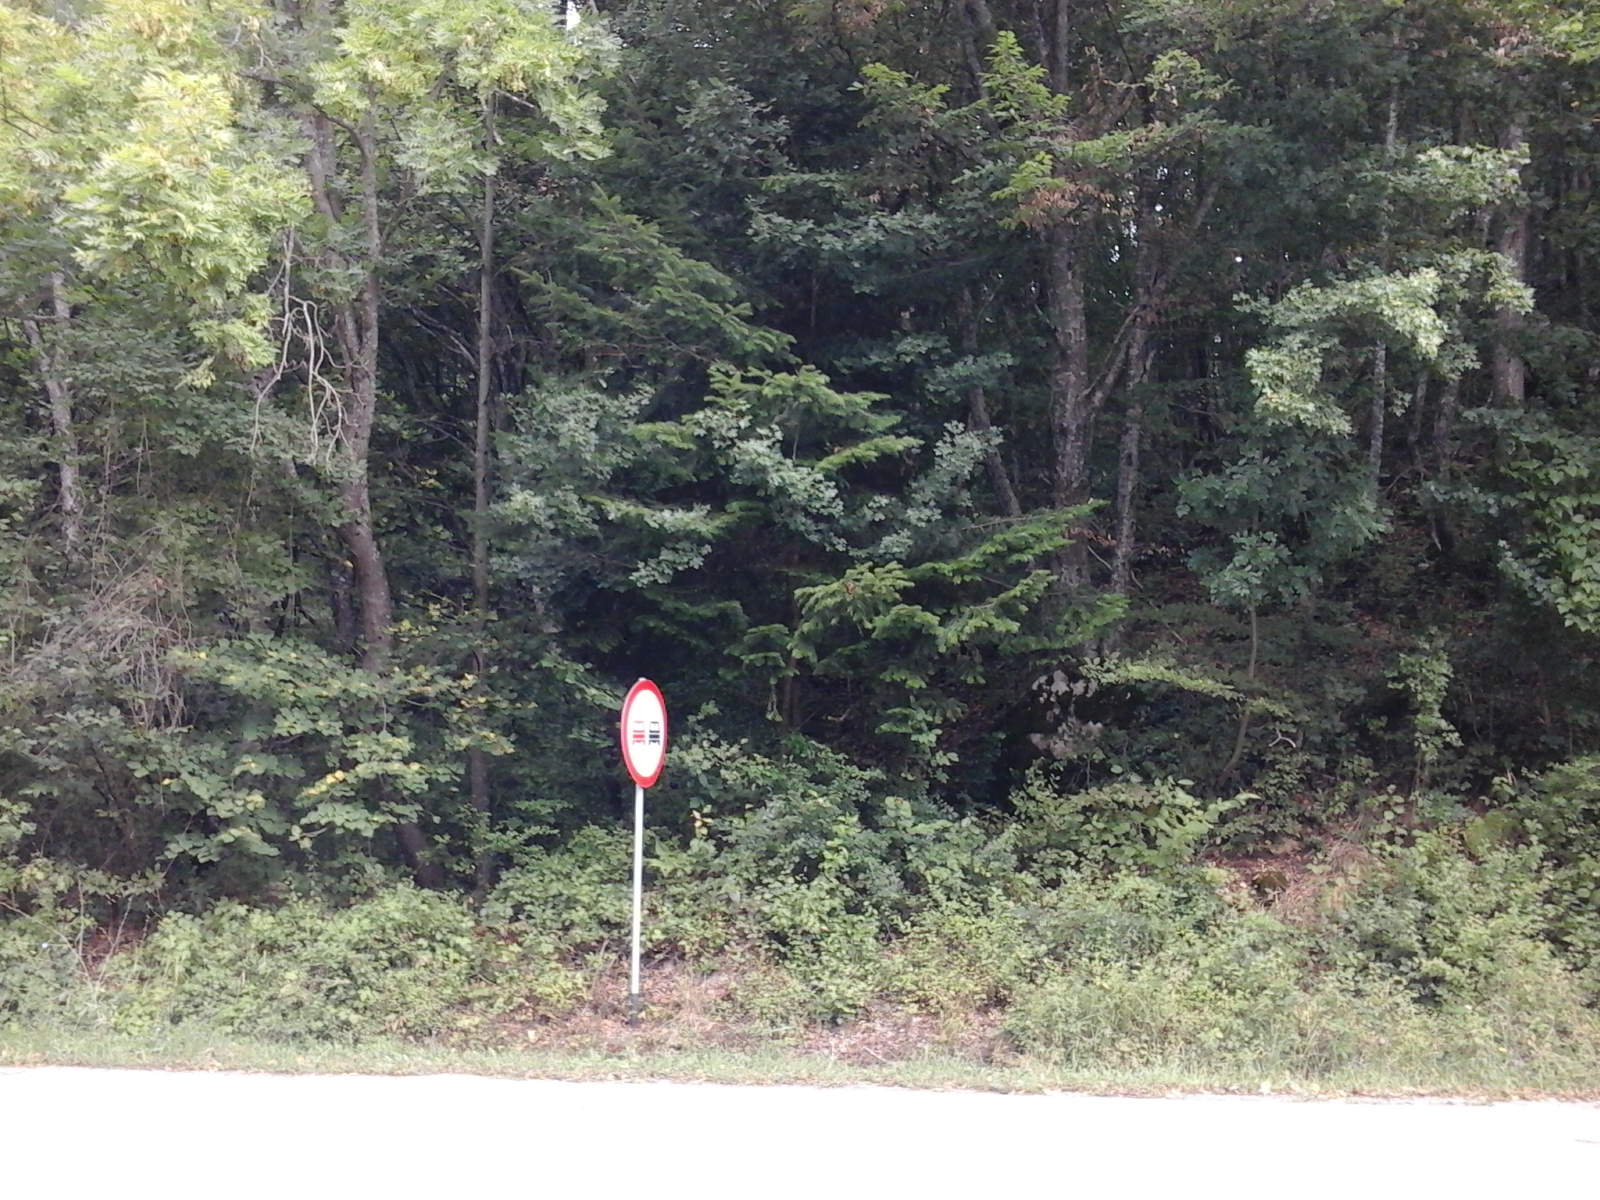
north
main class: Woodland
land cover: Broadleaved woodland
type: acidophilous oak and oak-birch forest
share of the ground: > 75 %
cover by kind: broadleaved forest trees 100 %
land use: Forestry
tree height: > 5 m
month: August
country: RO
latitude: 45.0317
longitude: 21.8763
